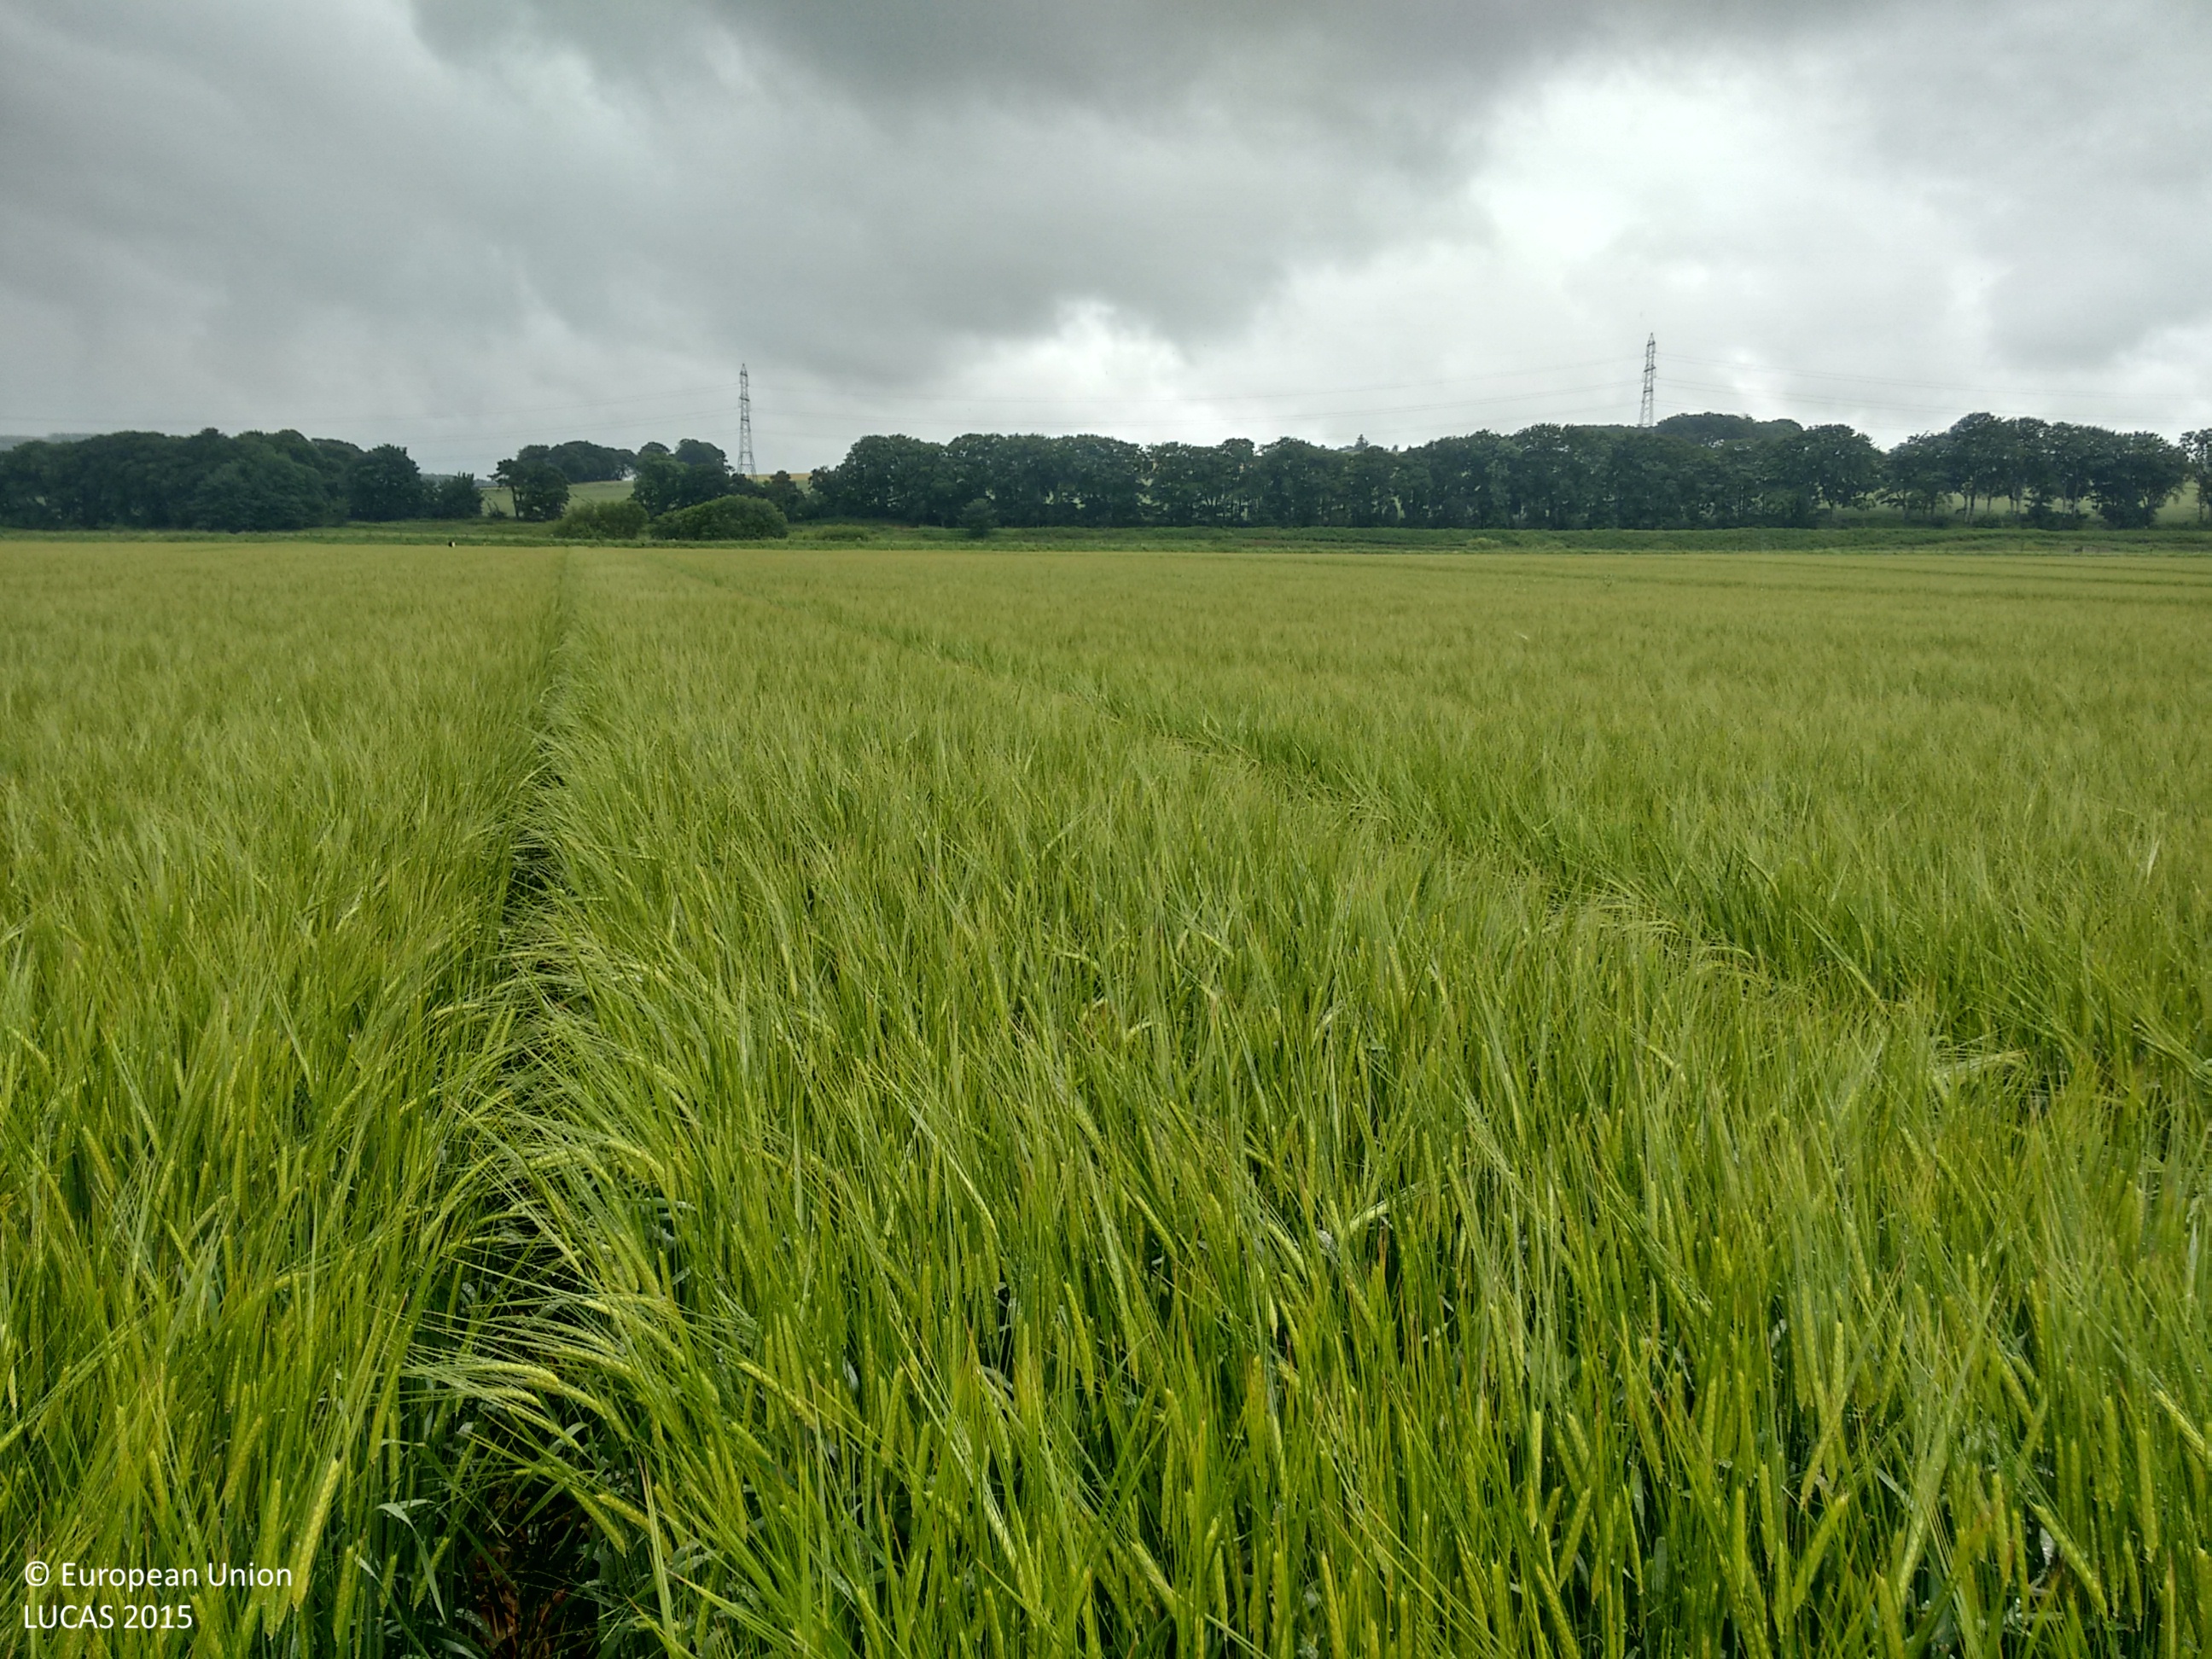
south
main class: Cropland
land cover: Barley
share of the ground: > 75 %
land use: Agriculture (excluding fallow land and kitchen gardens)
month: July
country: GB
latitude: 57.2333
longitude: -2.2934
